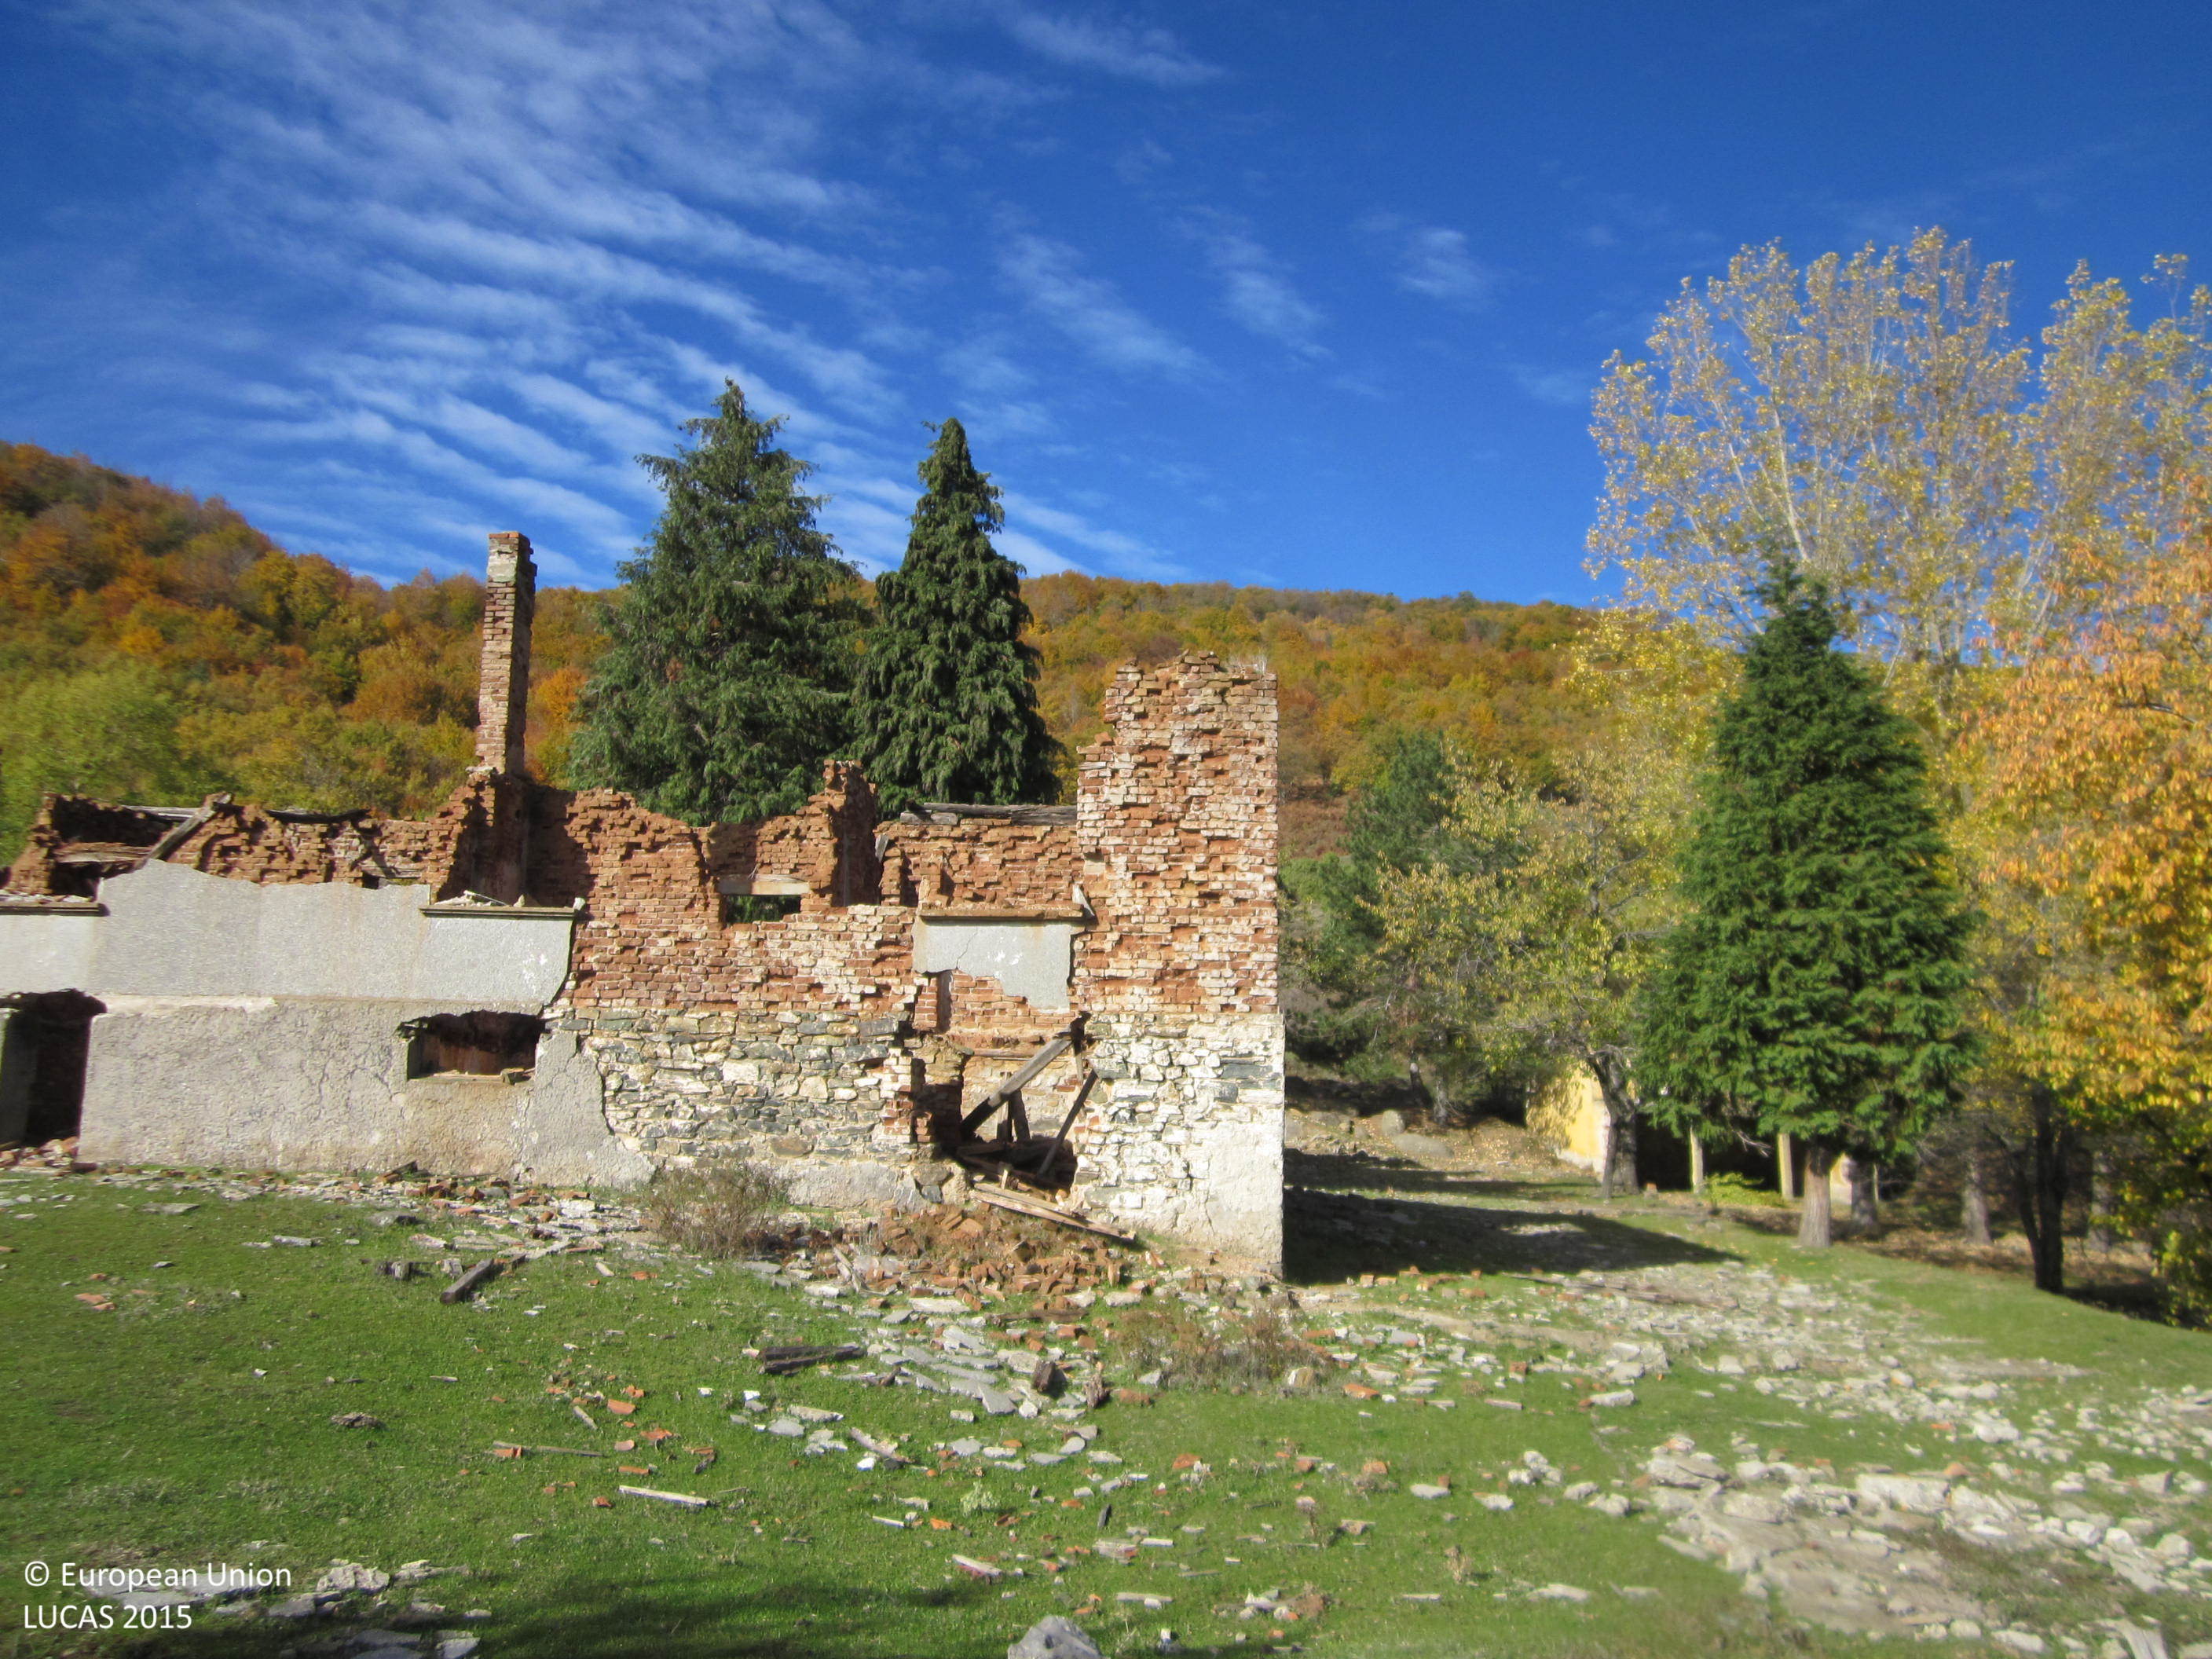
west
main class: Woodland
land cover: Pine dominated coniferous woodland
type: acidophilous oak and oak-birch forest
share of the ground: > 75 %
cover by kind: coniferous forest trees 100 %
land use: Forestry
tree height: > 5 m
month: November
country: BG
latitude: 41.3151
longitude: 25.6713
